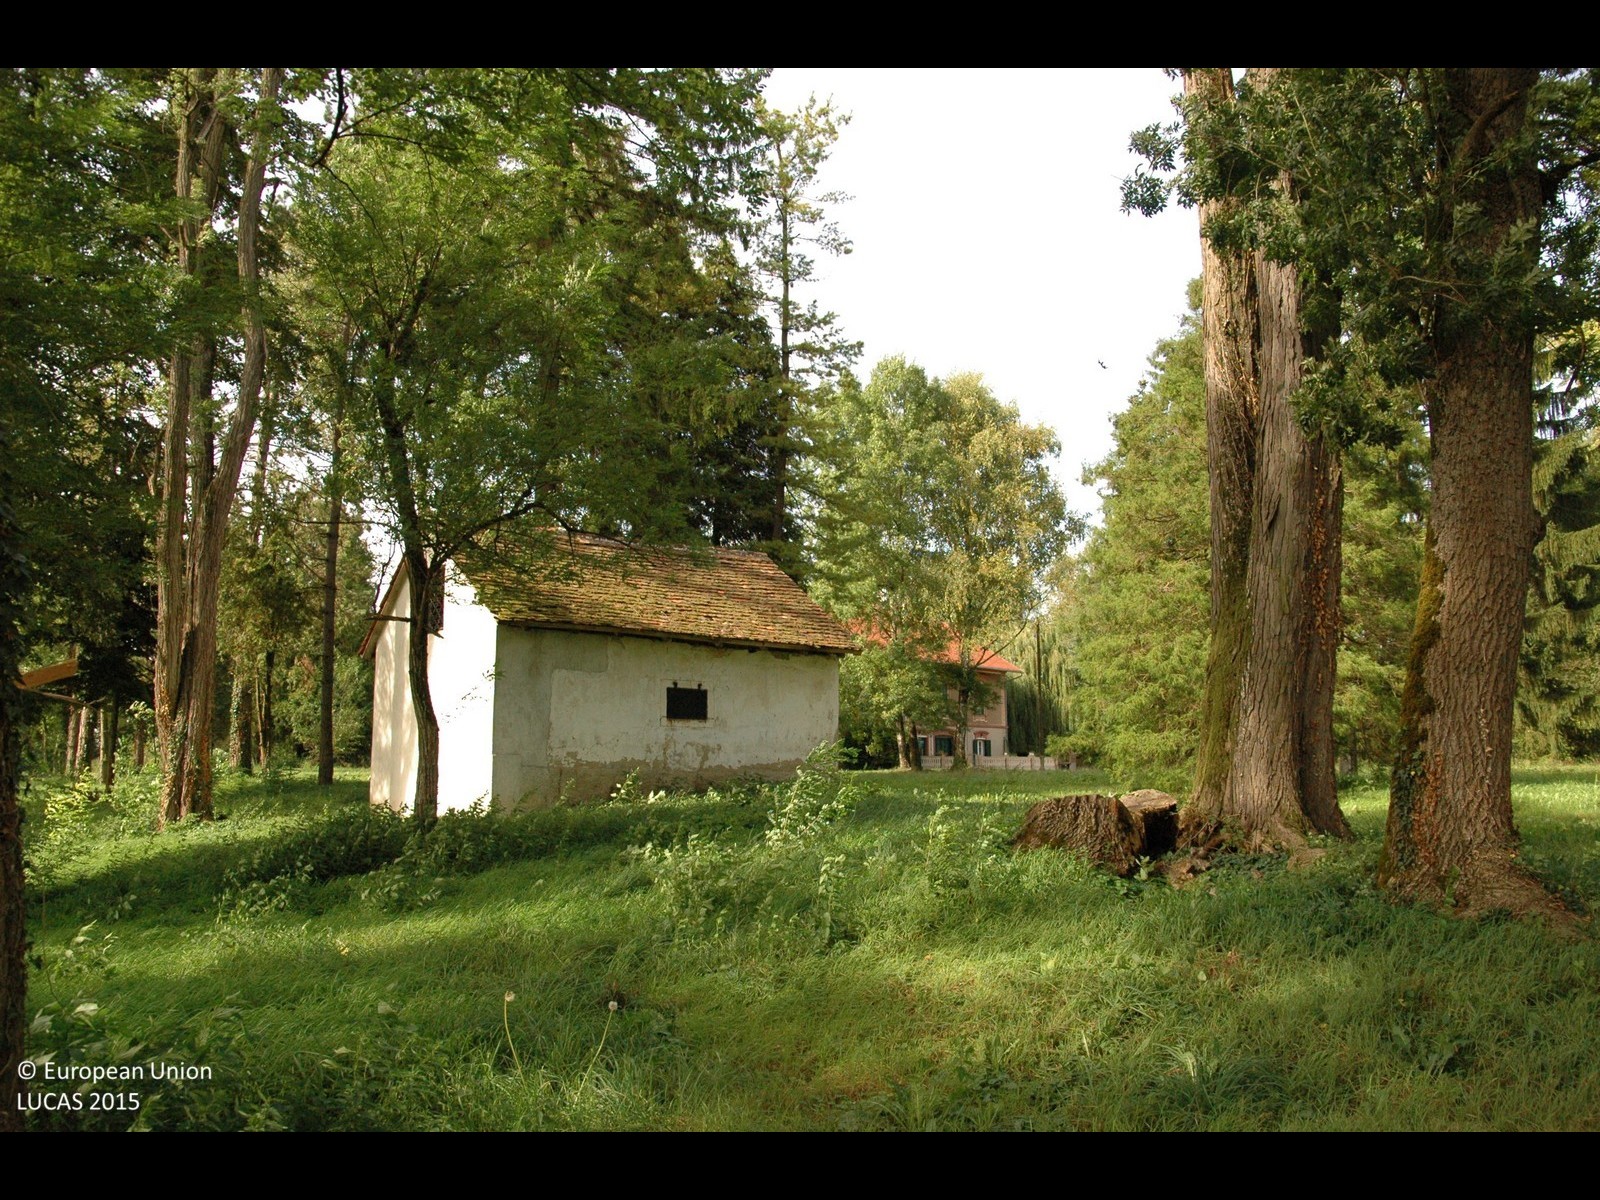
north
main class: Woodland
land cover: Broadleaved woodland
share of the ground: > 75 %
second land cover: Grassland without tree/shrub cover
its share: > 75 %
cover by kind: broadleaved forest trees 80 %, herbaceous plants 20 %
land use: Amenities, museums, leisure
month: September
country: HR
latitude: 45.7327
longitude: 15.9732
